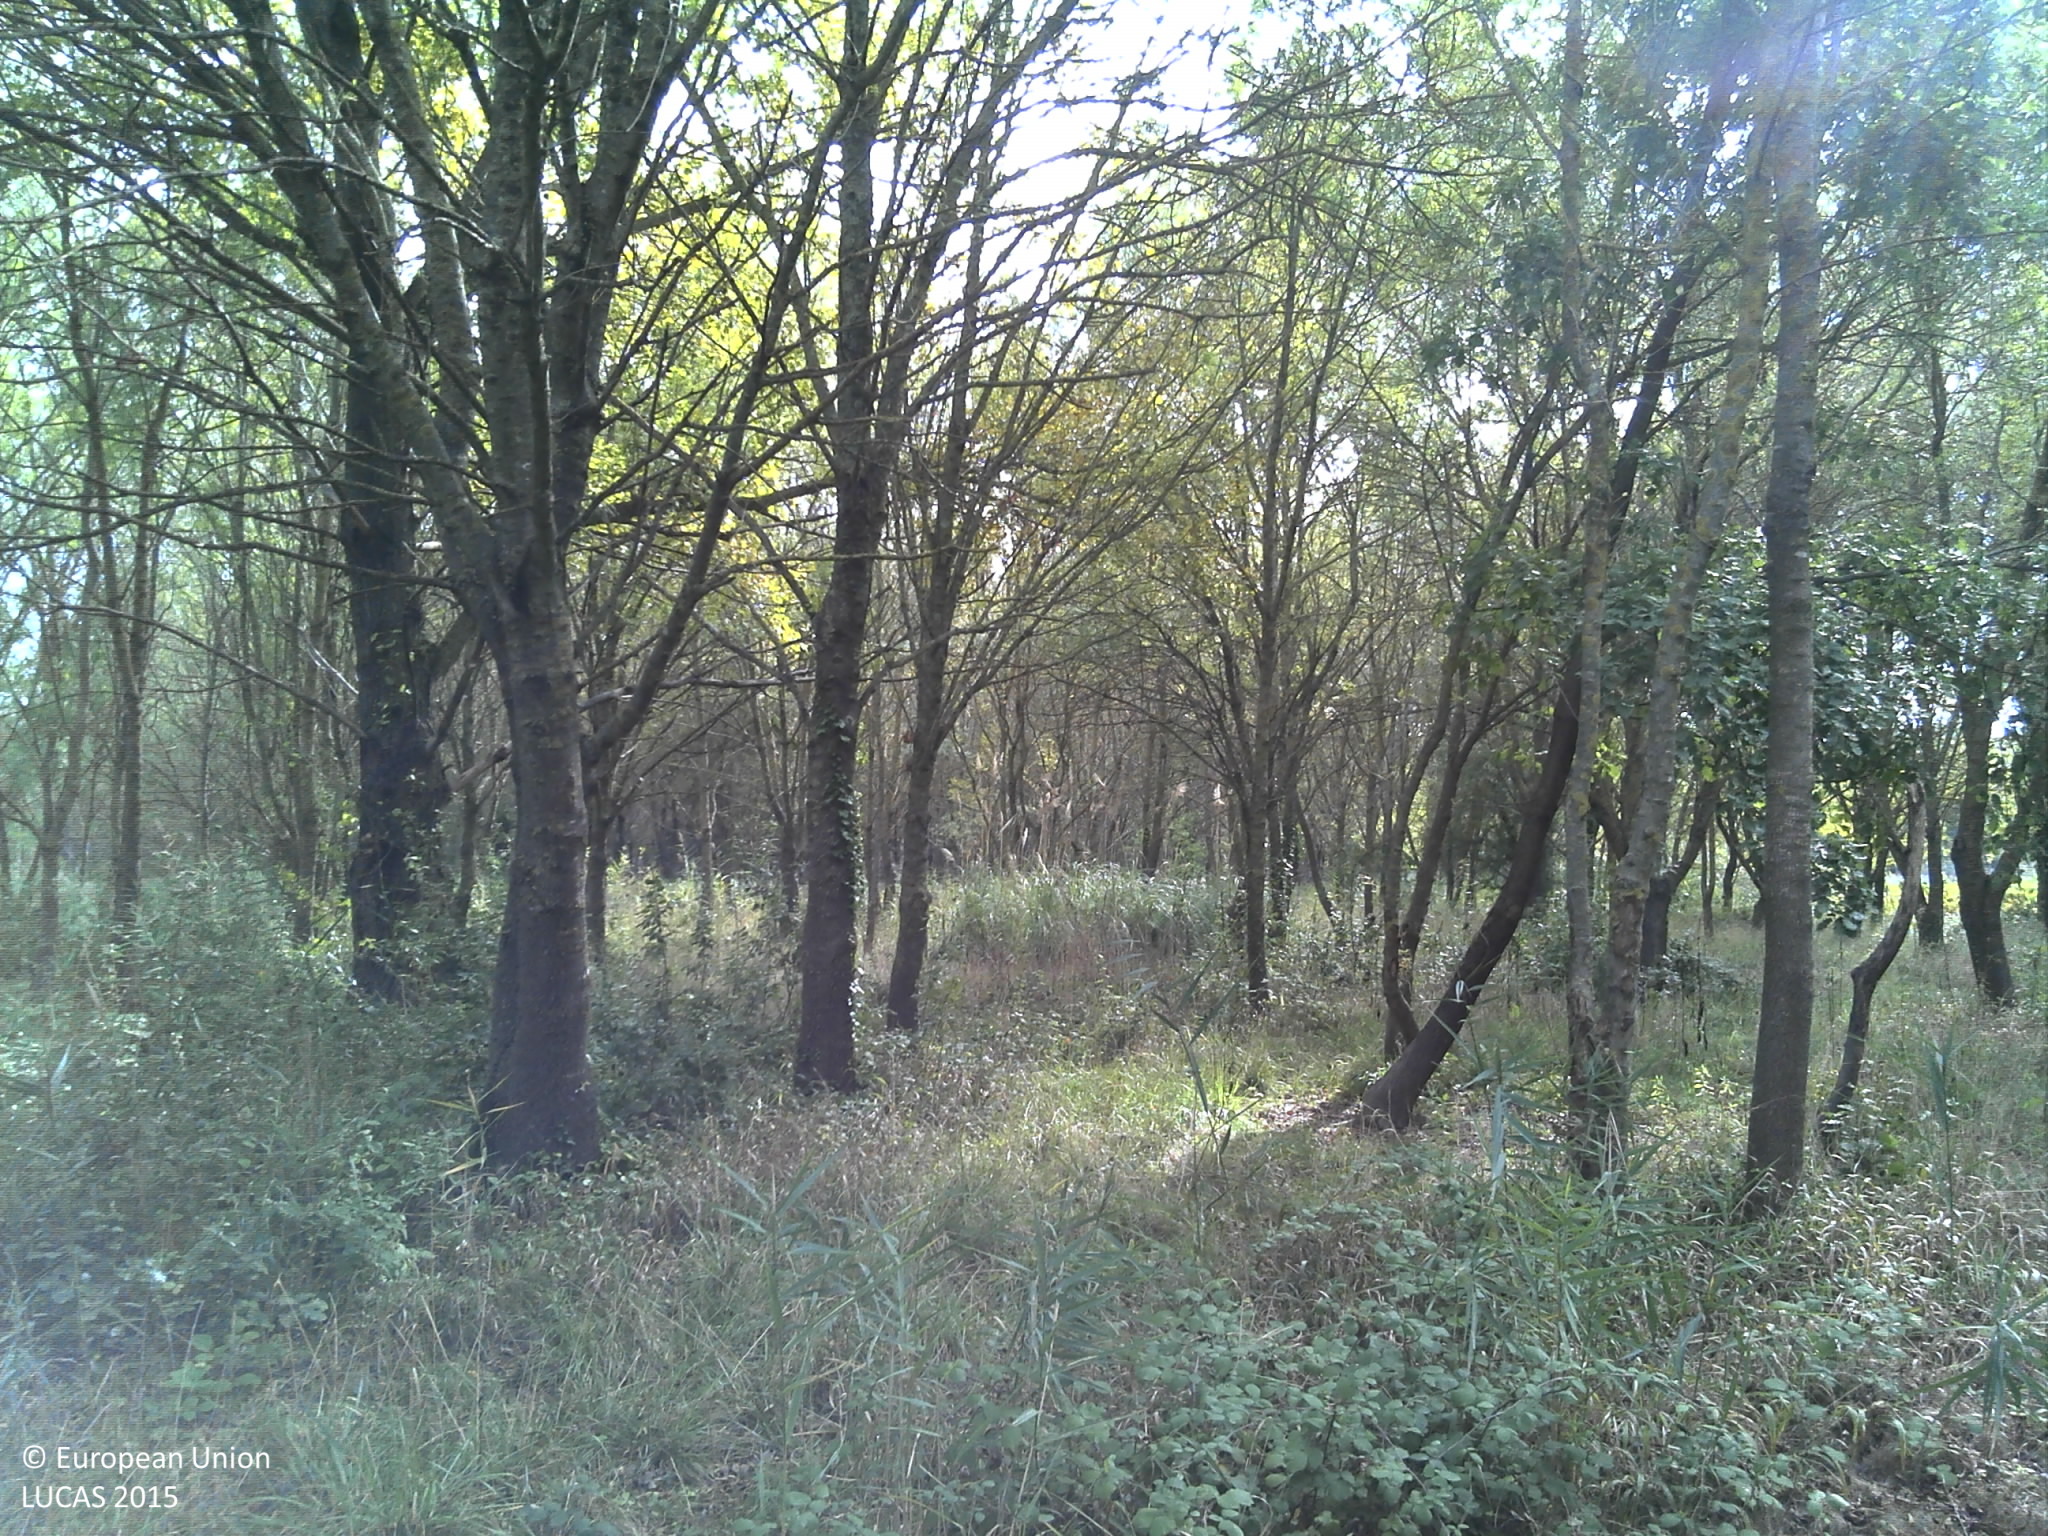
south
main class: Woodland
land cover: Broadleaved woodland
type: thermophilous deciduous forest
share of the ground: > 75 %
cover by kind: broadleaved forest trees 70 %, herbaceous plants 20 %, unconsolidated bare surface 10 %
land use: Abandoned areas
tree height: > 5 m
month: October
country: FR
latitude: 43.2646
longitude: 6.5717
